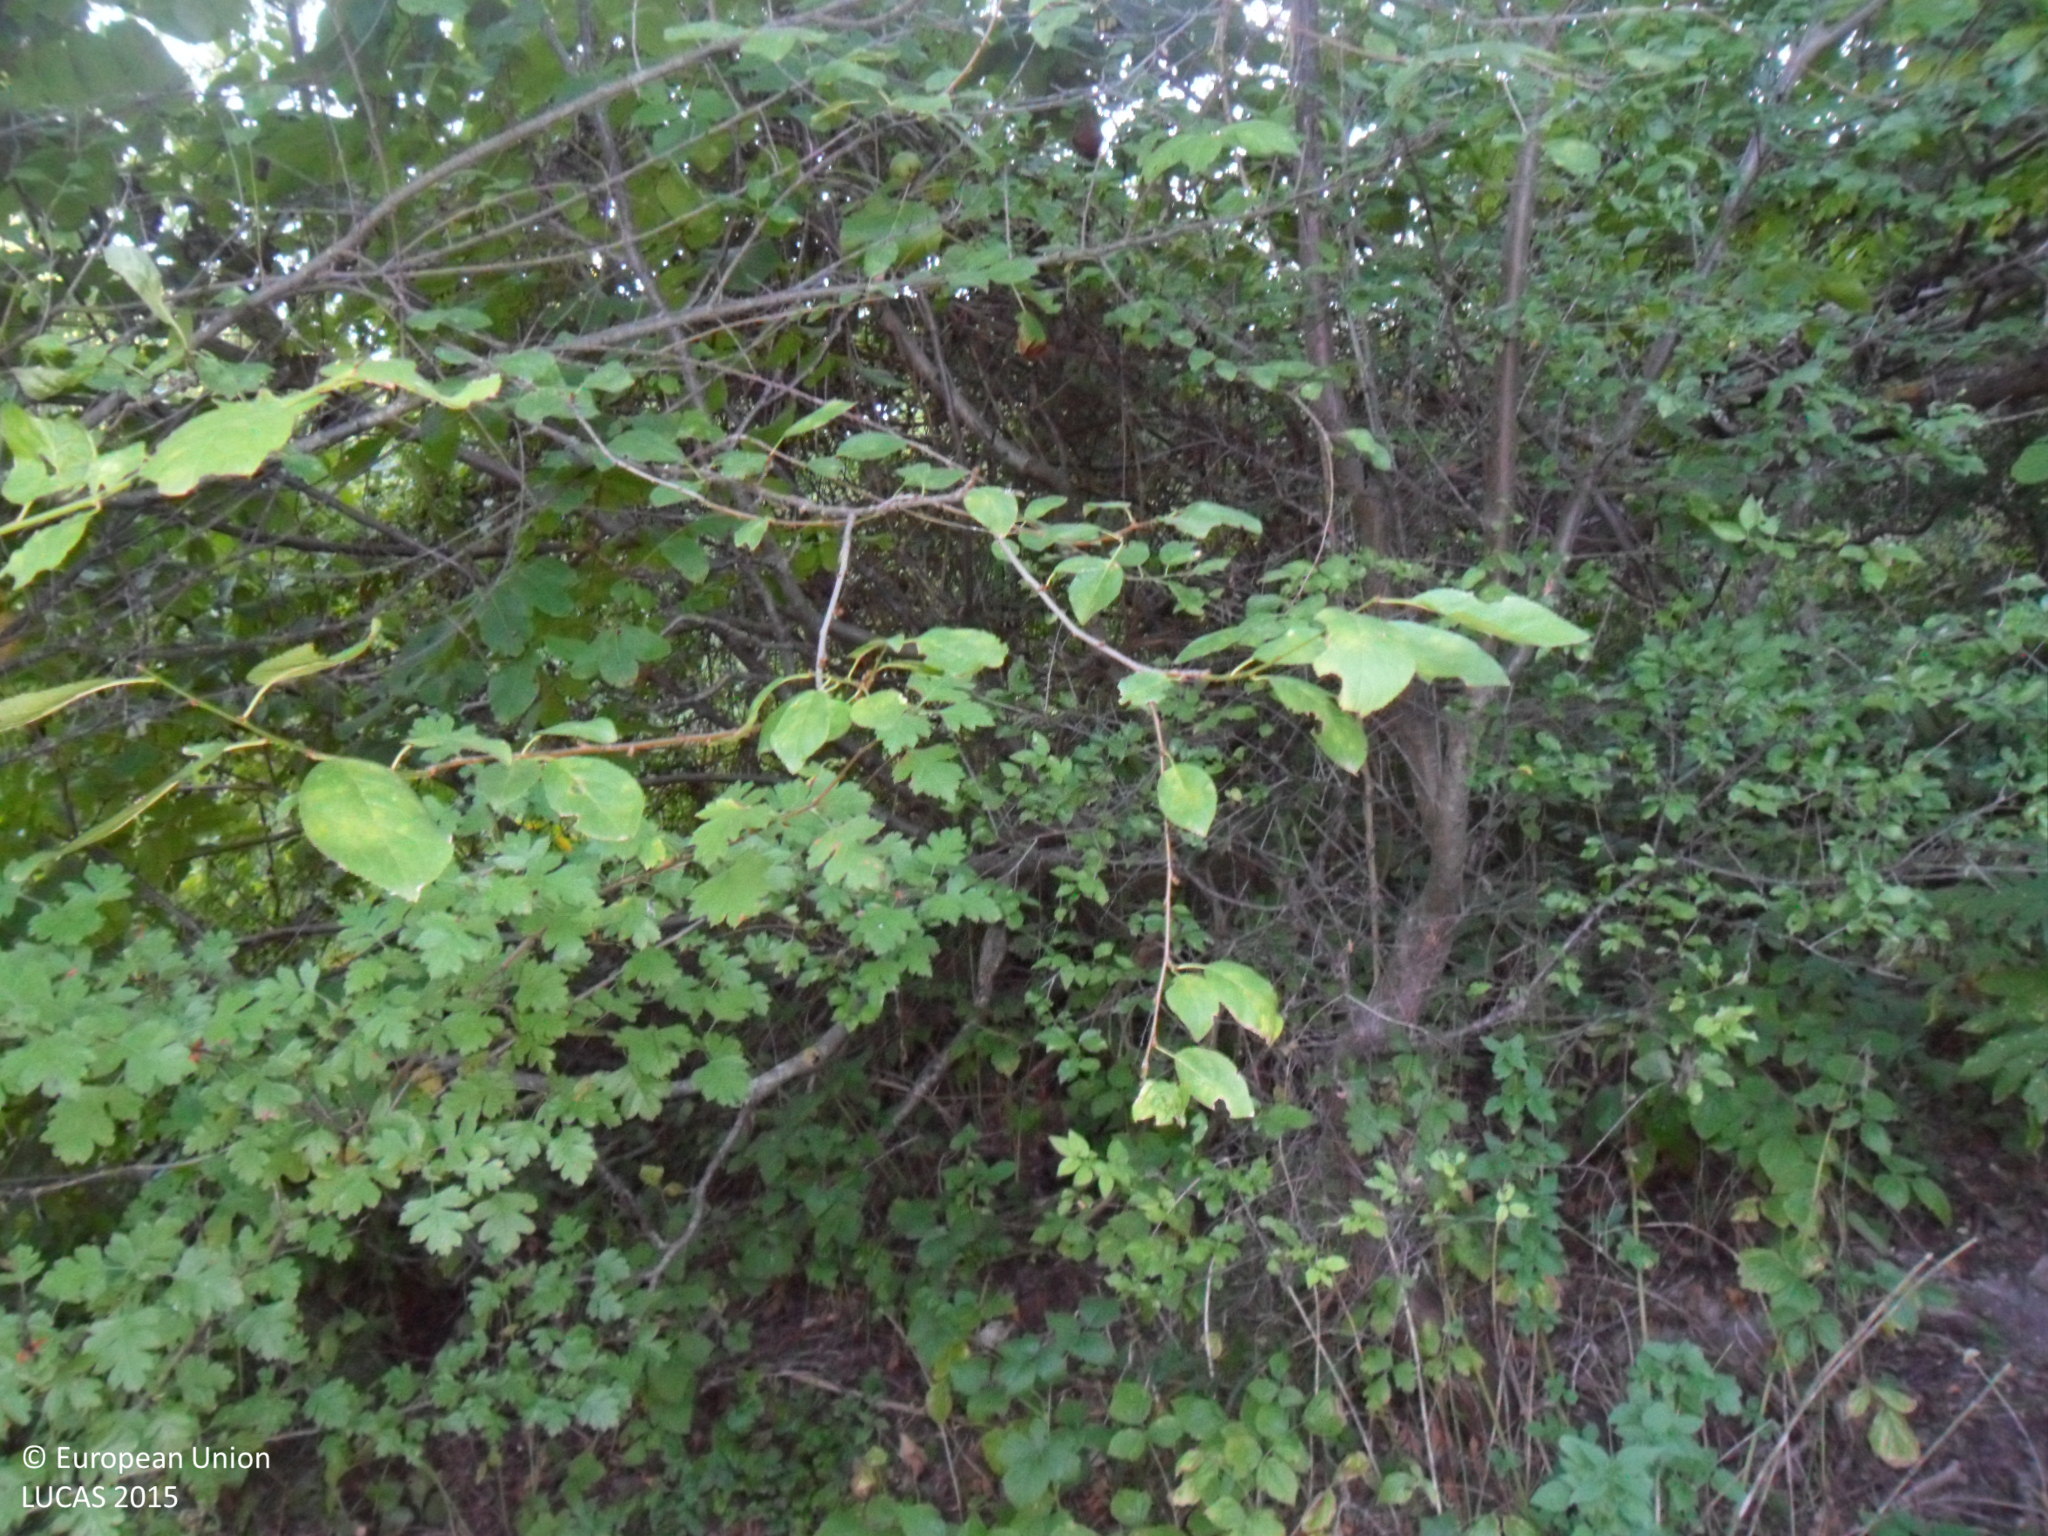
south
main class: Woodland
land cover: Broadleaved woodland
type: mesophytic deciduous forest
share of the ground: 50 - 75 %
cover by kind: broadleaved forest trees 60 %, shrubs 30 %, herbaceous plants 10 %
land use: Forestry
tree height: > 5 m
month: September
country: BG
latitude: 43.1616
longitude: 26.7473
